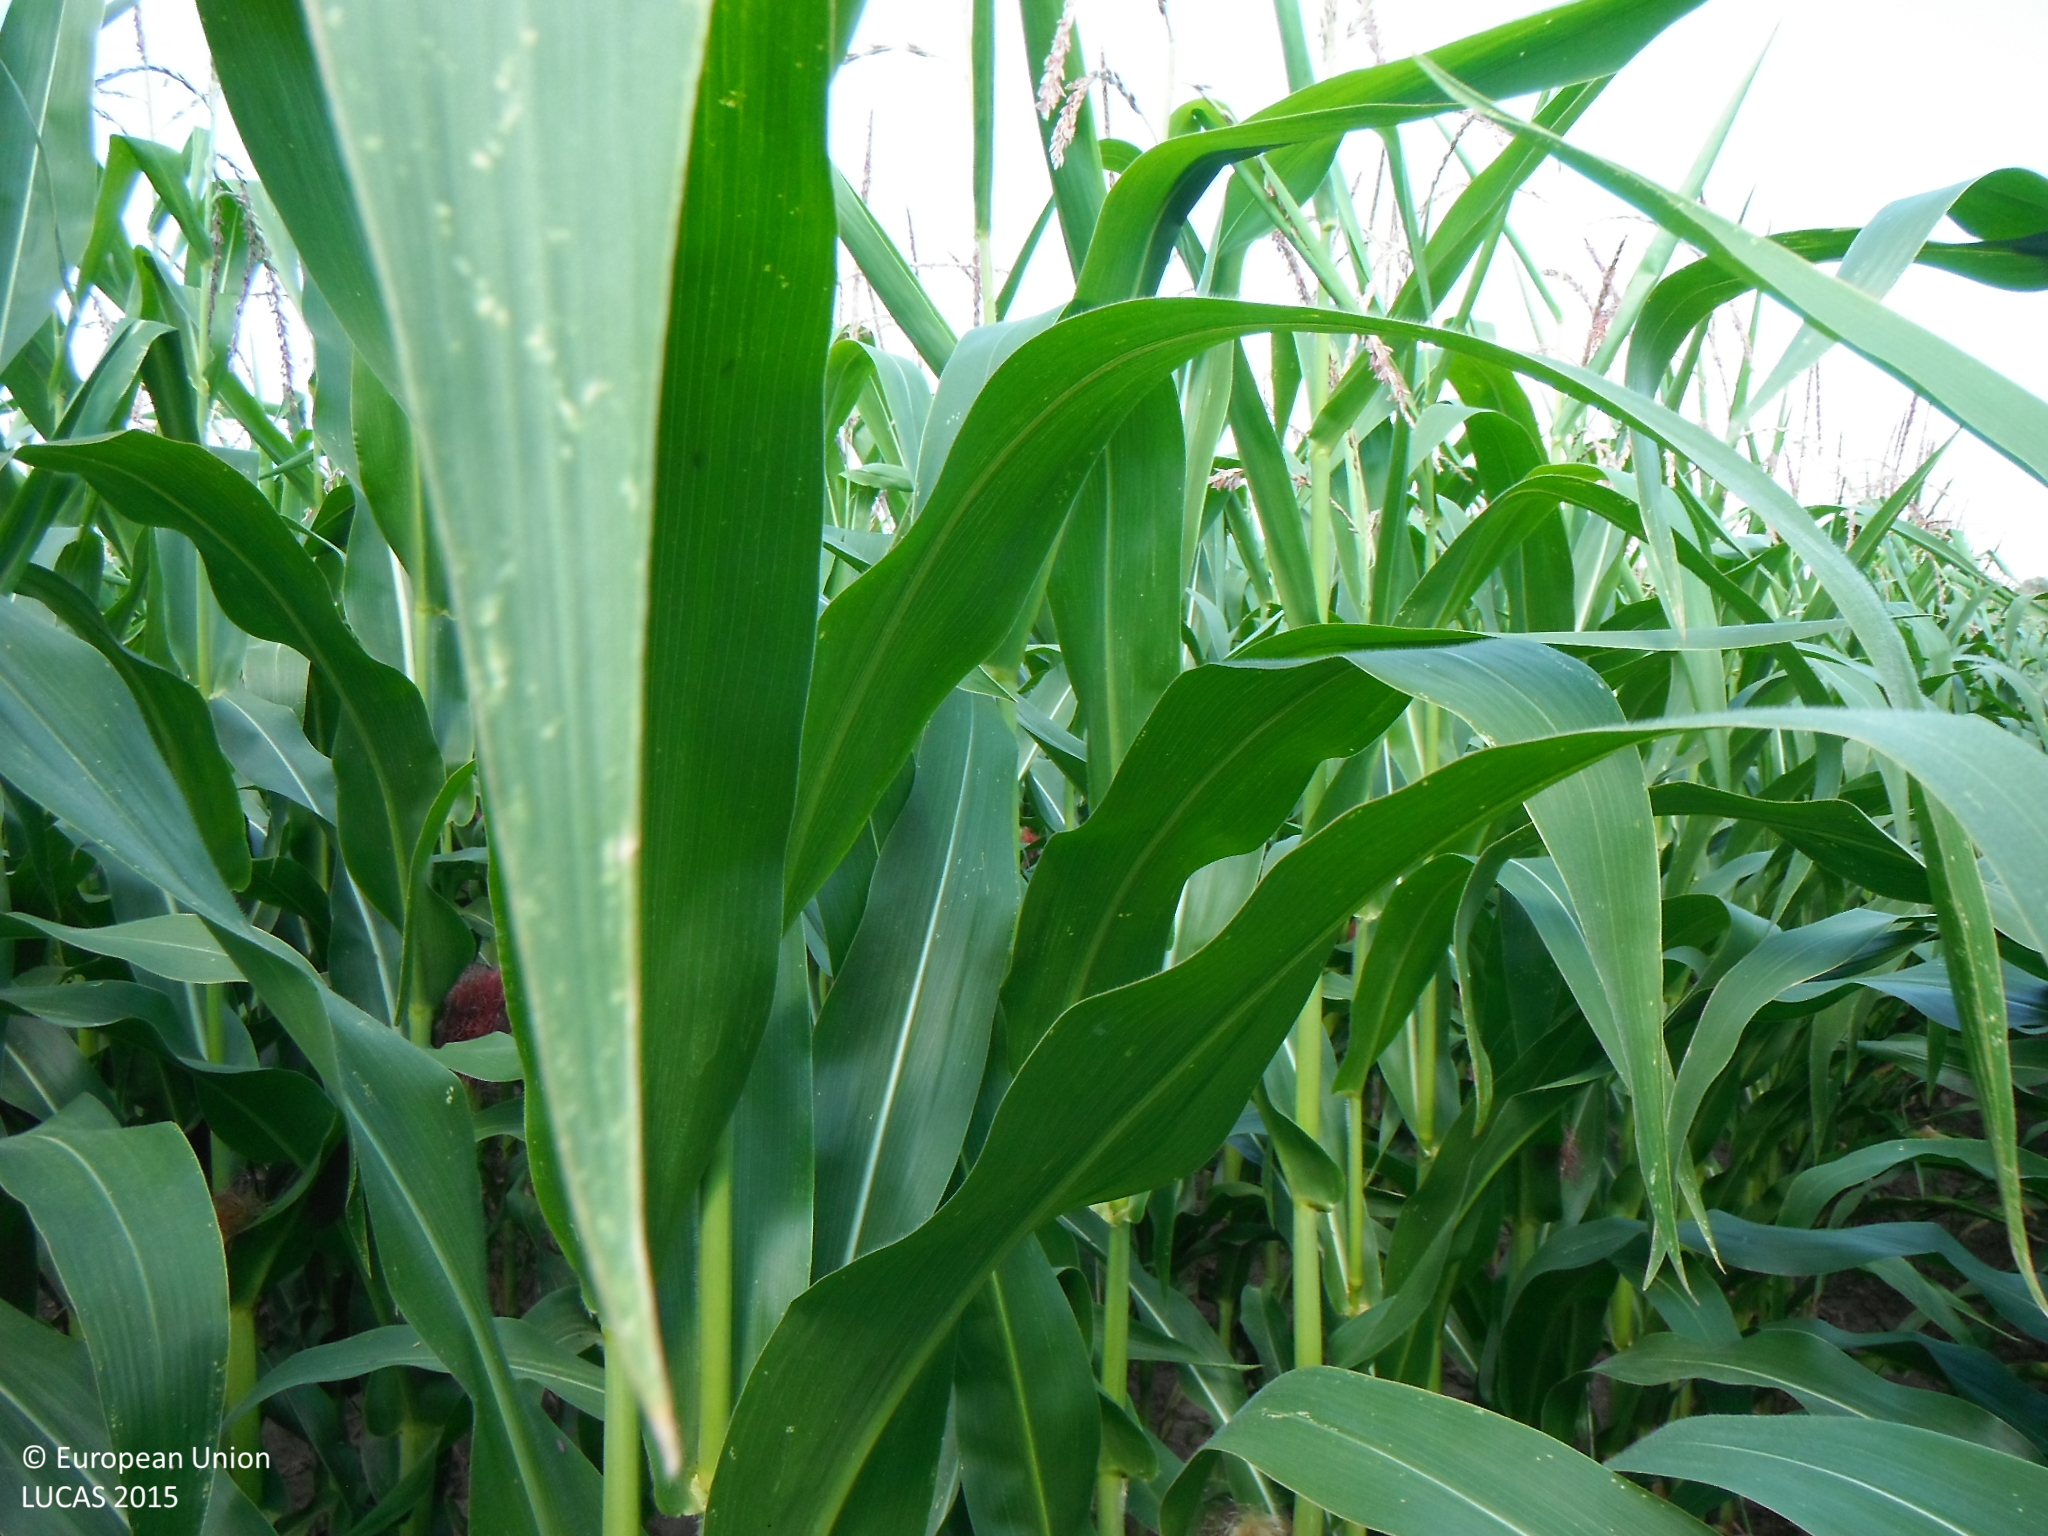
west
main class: Cropland
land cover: Maize
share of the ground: > 75 %
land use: Agriculture (excluding fallow land and kitchen gardens)
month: July
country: SK
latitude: 48.3136
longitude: 19.7761
